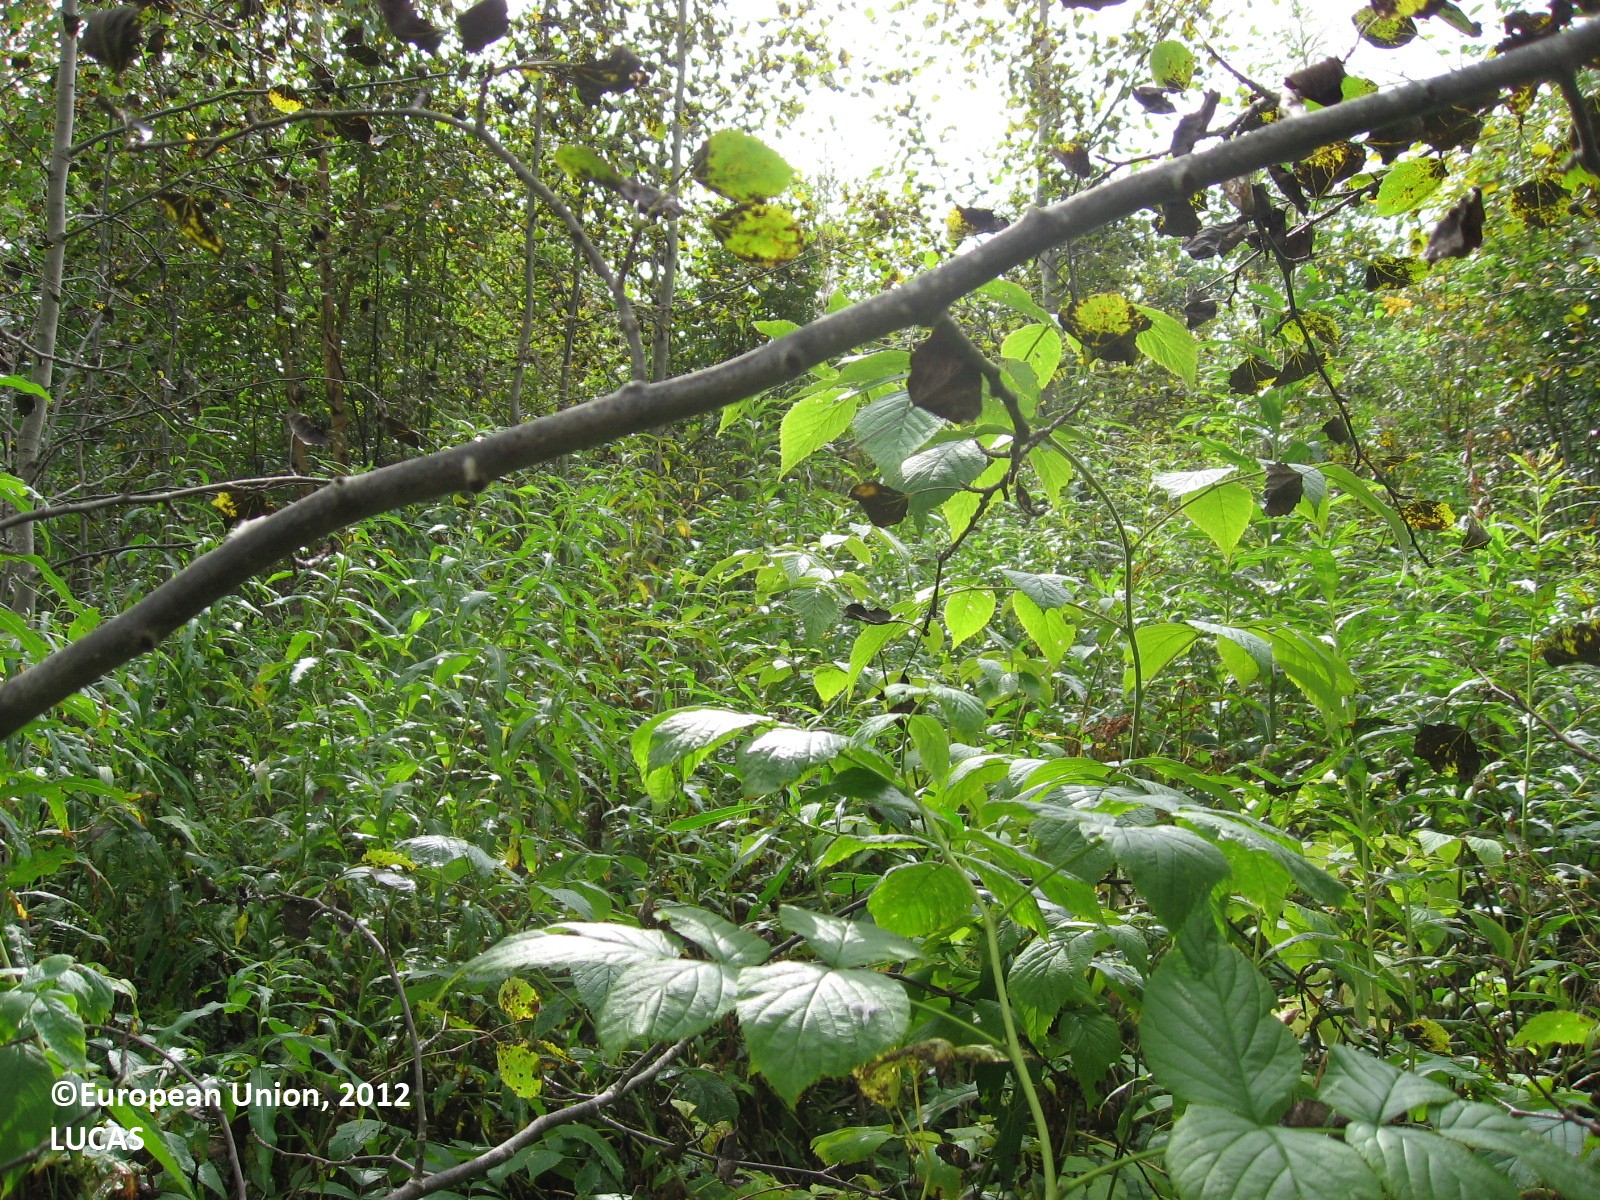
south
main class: Woodland
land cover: Broadleaved woodland
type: boreal forest
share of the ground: > 75 %
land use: Forestry
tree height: > 5 m
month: September
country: FI
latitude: 60.9459
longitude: 25.2378
